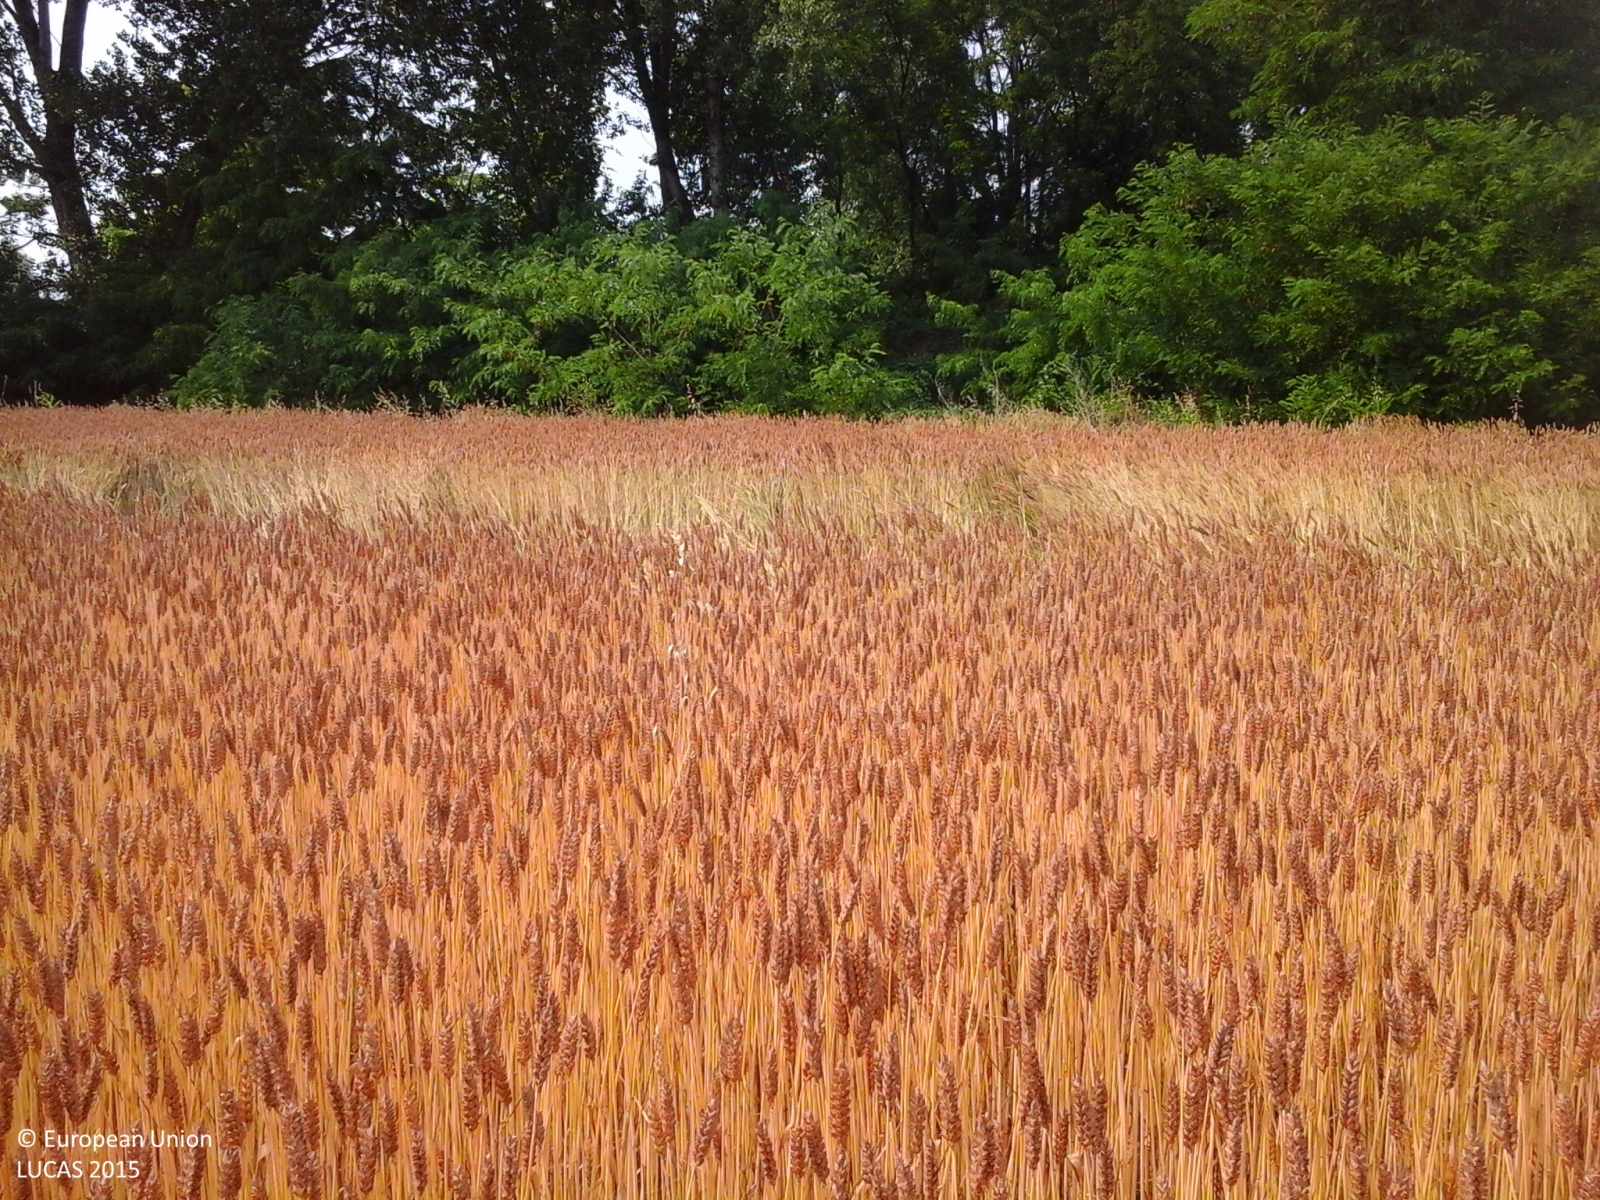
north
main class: Cropland
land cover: Common wheat
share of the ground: > 75 %
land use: Agriculture (excluding fallow land and kitchen gardens)
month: June
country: IT
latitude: 45.4273
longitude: 11.0335
